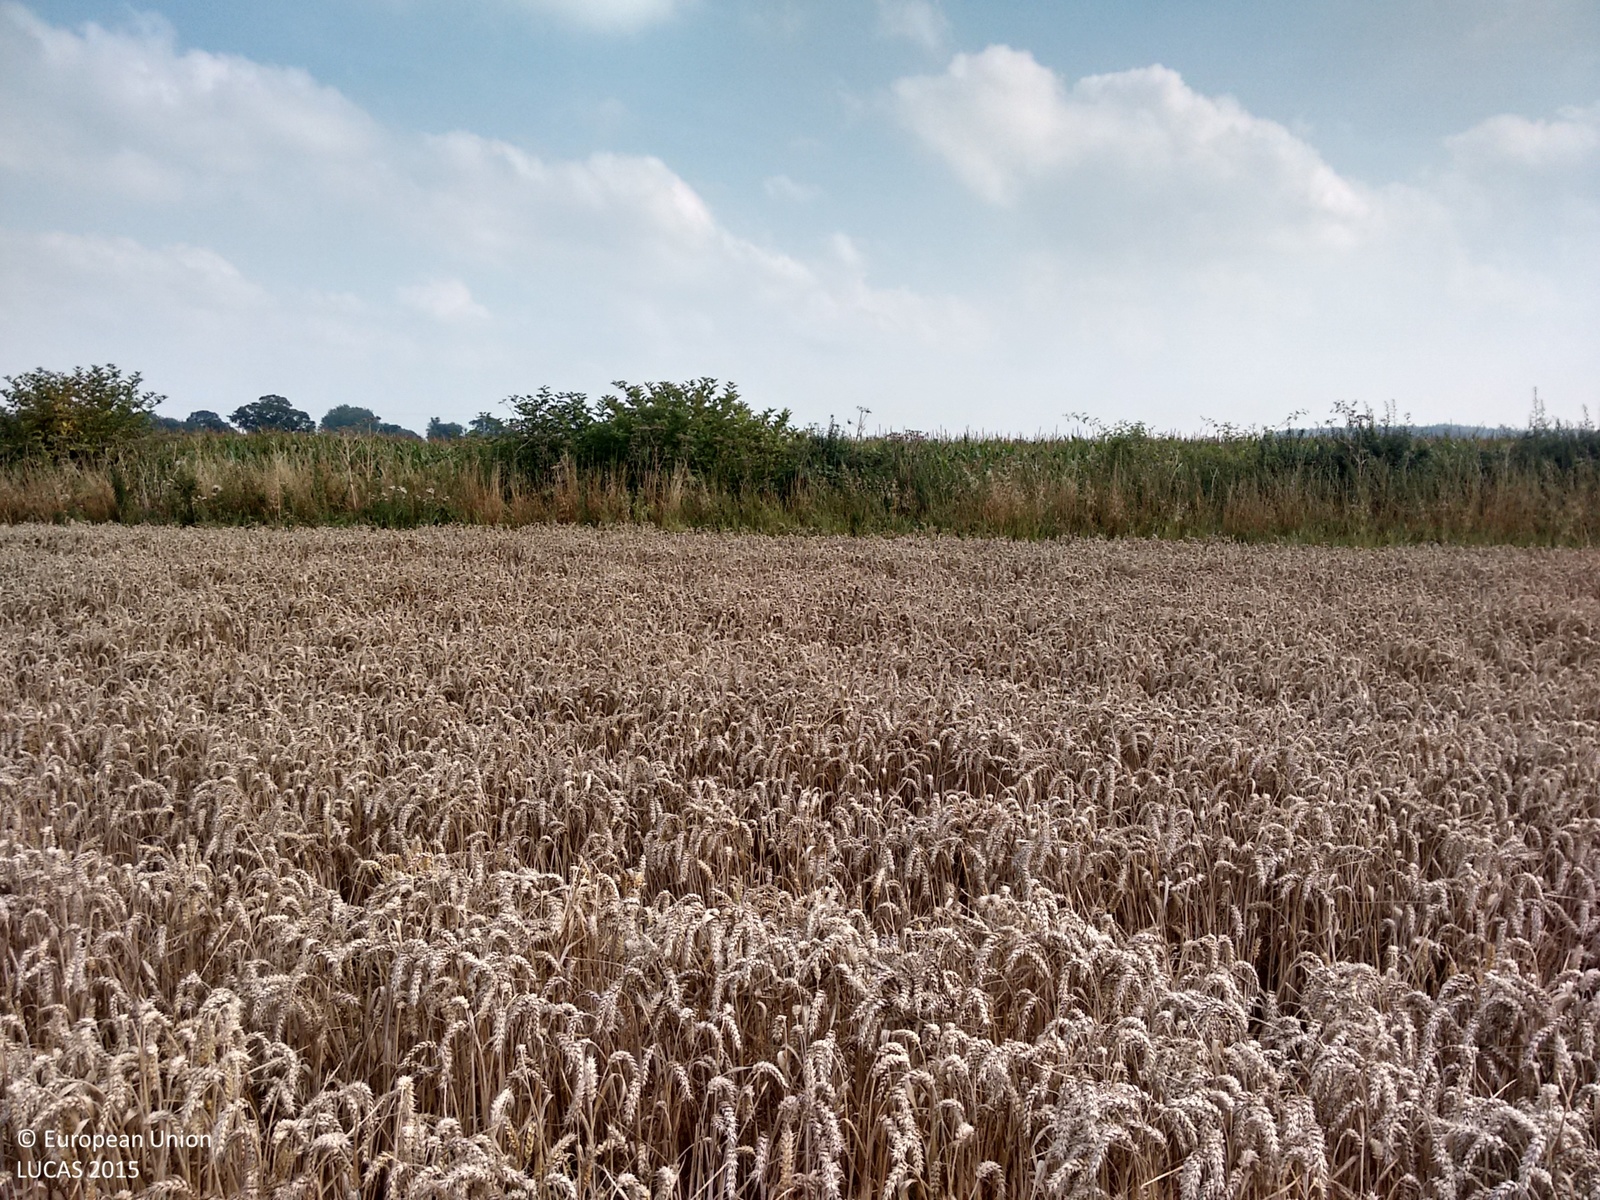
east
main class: Cropland
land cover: Common wheat
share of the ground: > 75 %
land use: Agriculture (excluding fallow land and kitchen gardens)
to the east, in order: Common wheat; Grass margins; Abandoned hedges; Grass margins; Maize
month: September
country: GB
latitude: 52.7221
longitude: -2.9398
